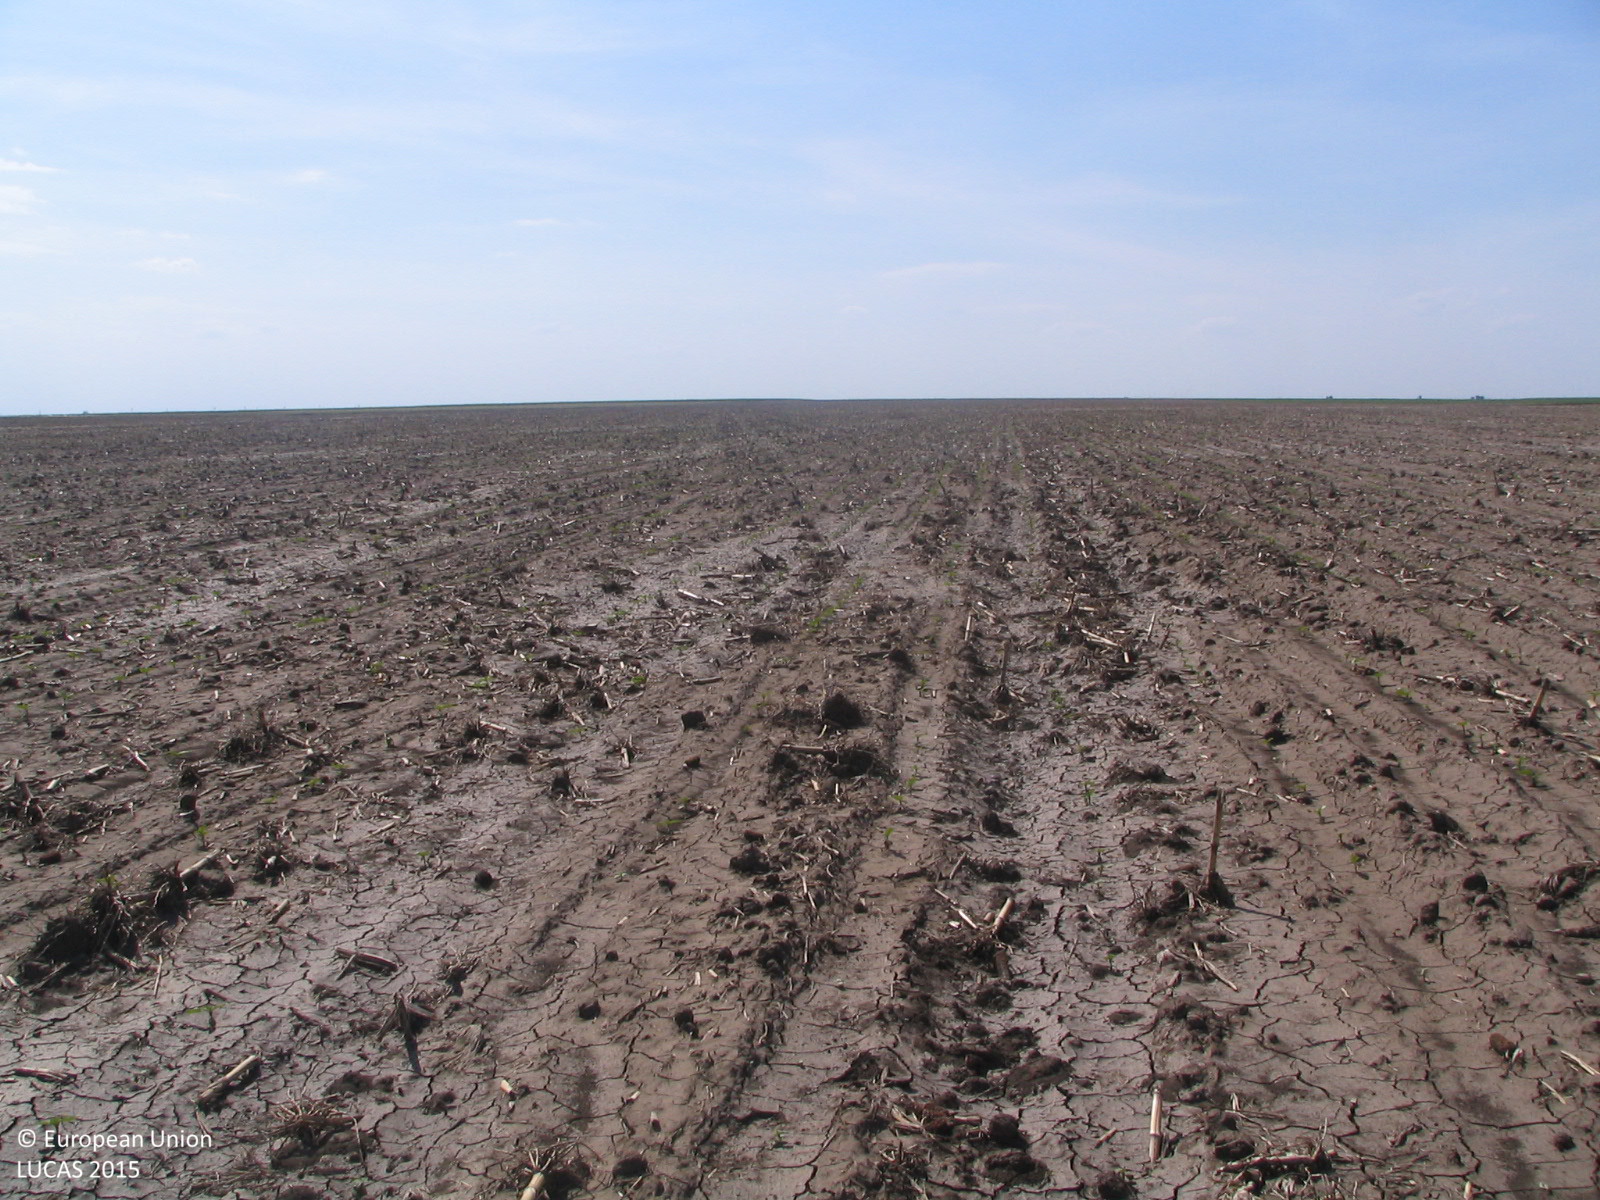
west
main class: Cropland
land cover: Sunflower
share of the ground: < 10 %
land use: Agriculture (excluding fallow land and kitchen gardens)
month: May
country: BG
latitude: 43.5776
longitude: 24.0097
